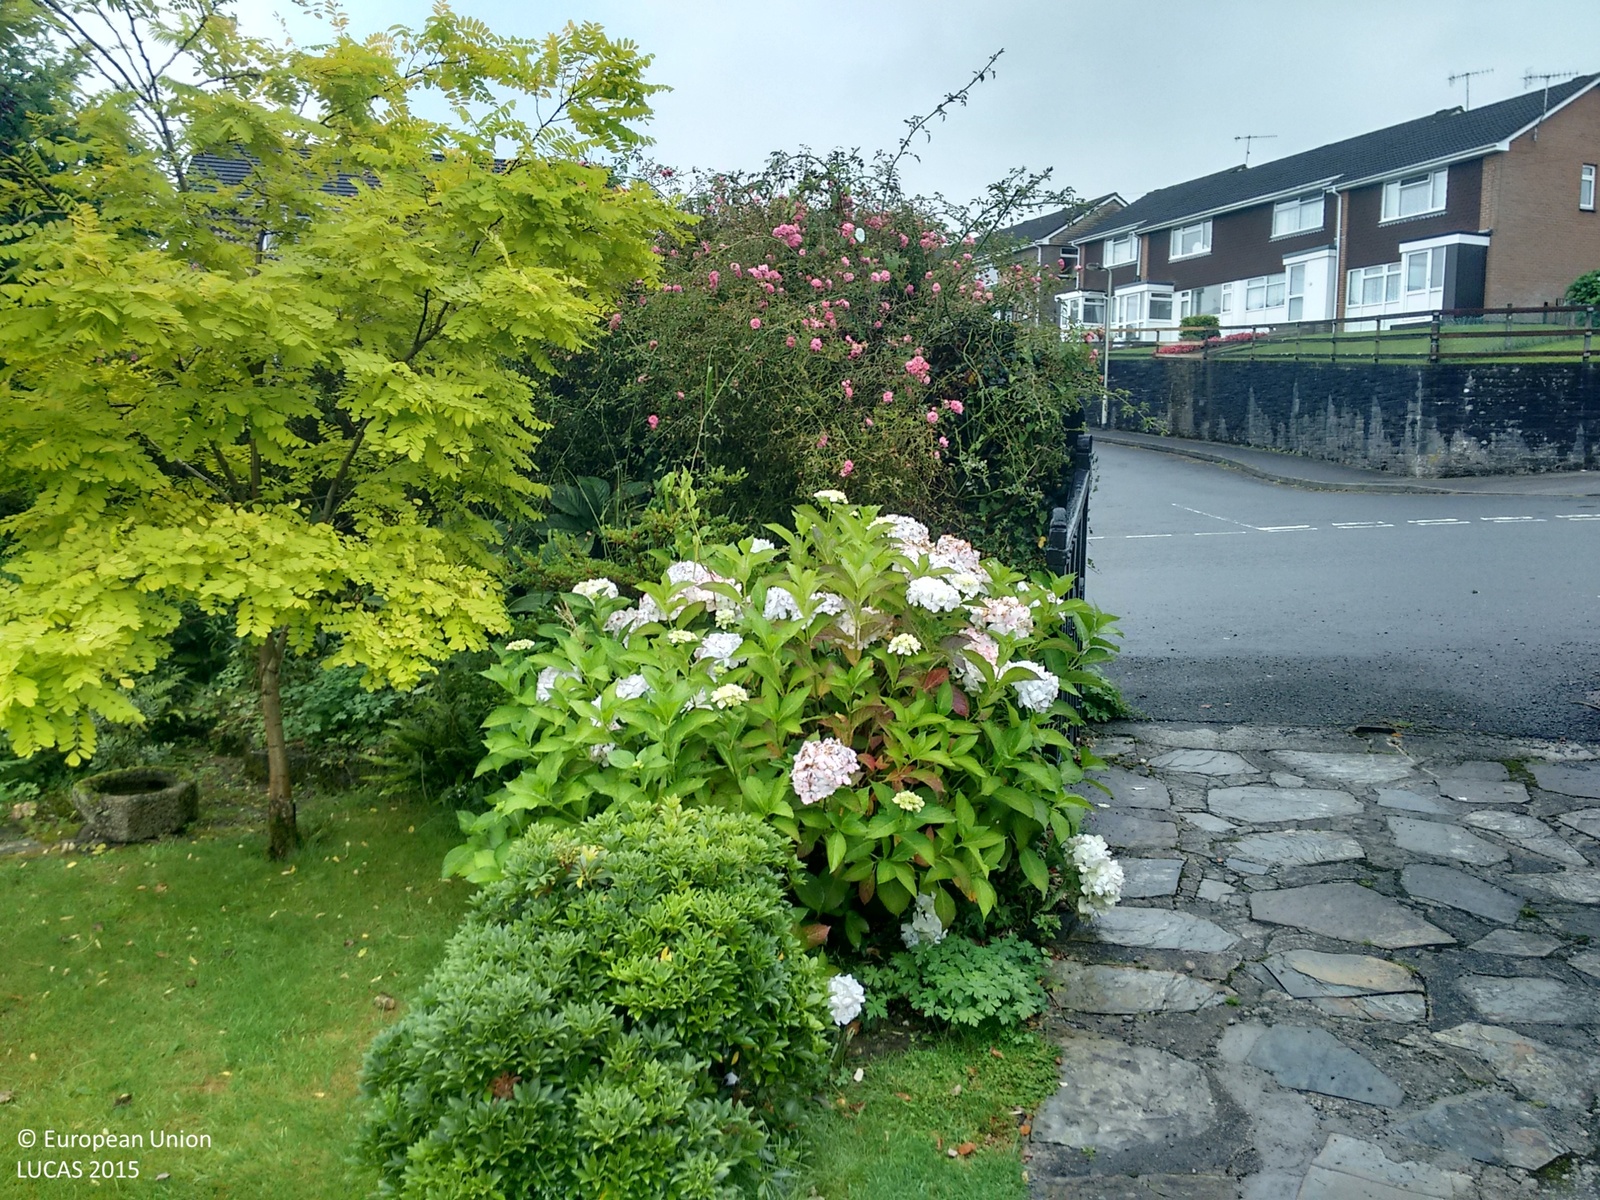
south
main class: Grassland
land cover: Grassland with sparse tree/shrub cover
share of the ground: > 75 %
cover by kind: herbaceous plants 95 %, broadleaved forest trees 5 %
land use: Residential
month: August
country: GB
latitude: 50.5078
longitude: -4.0976
